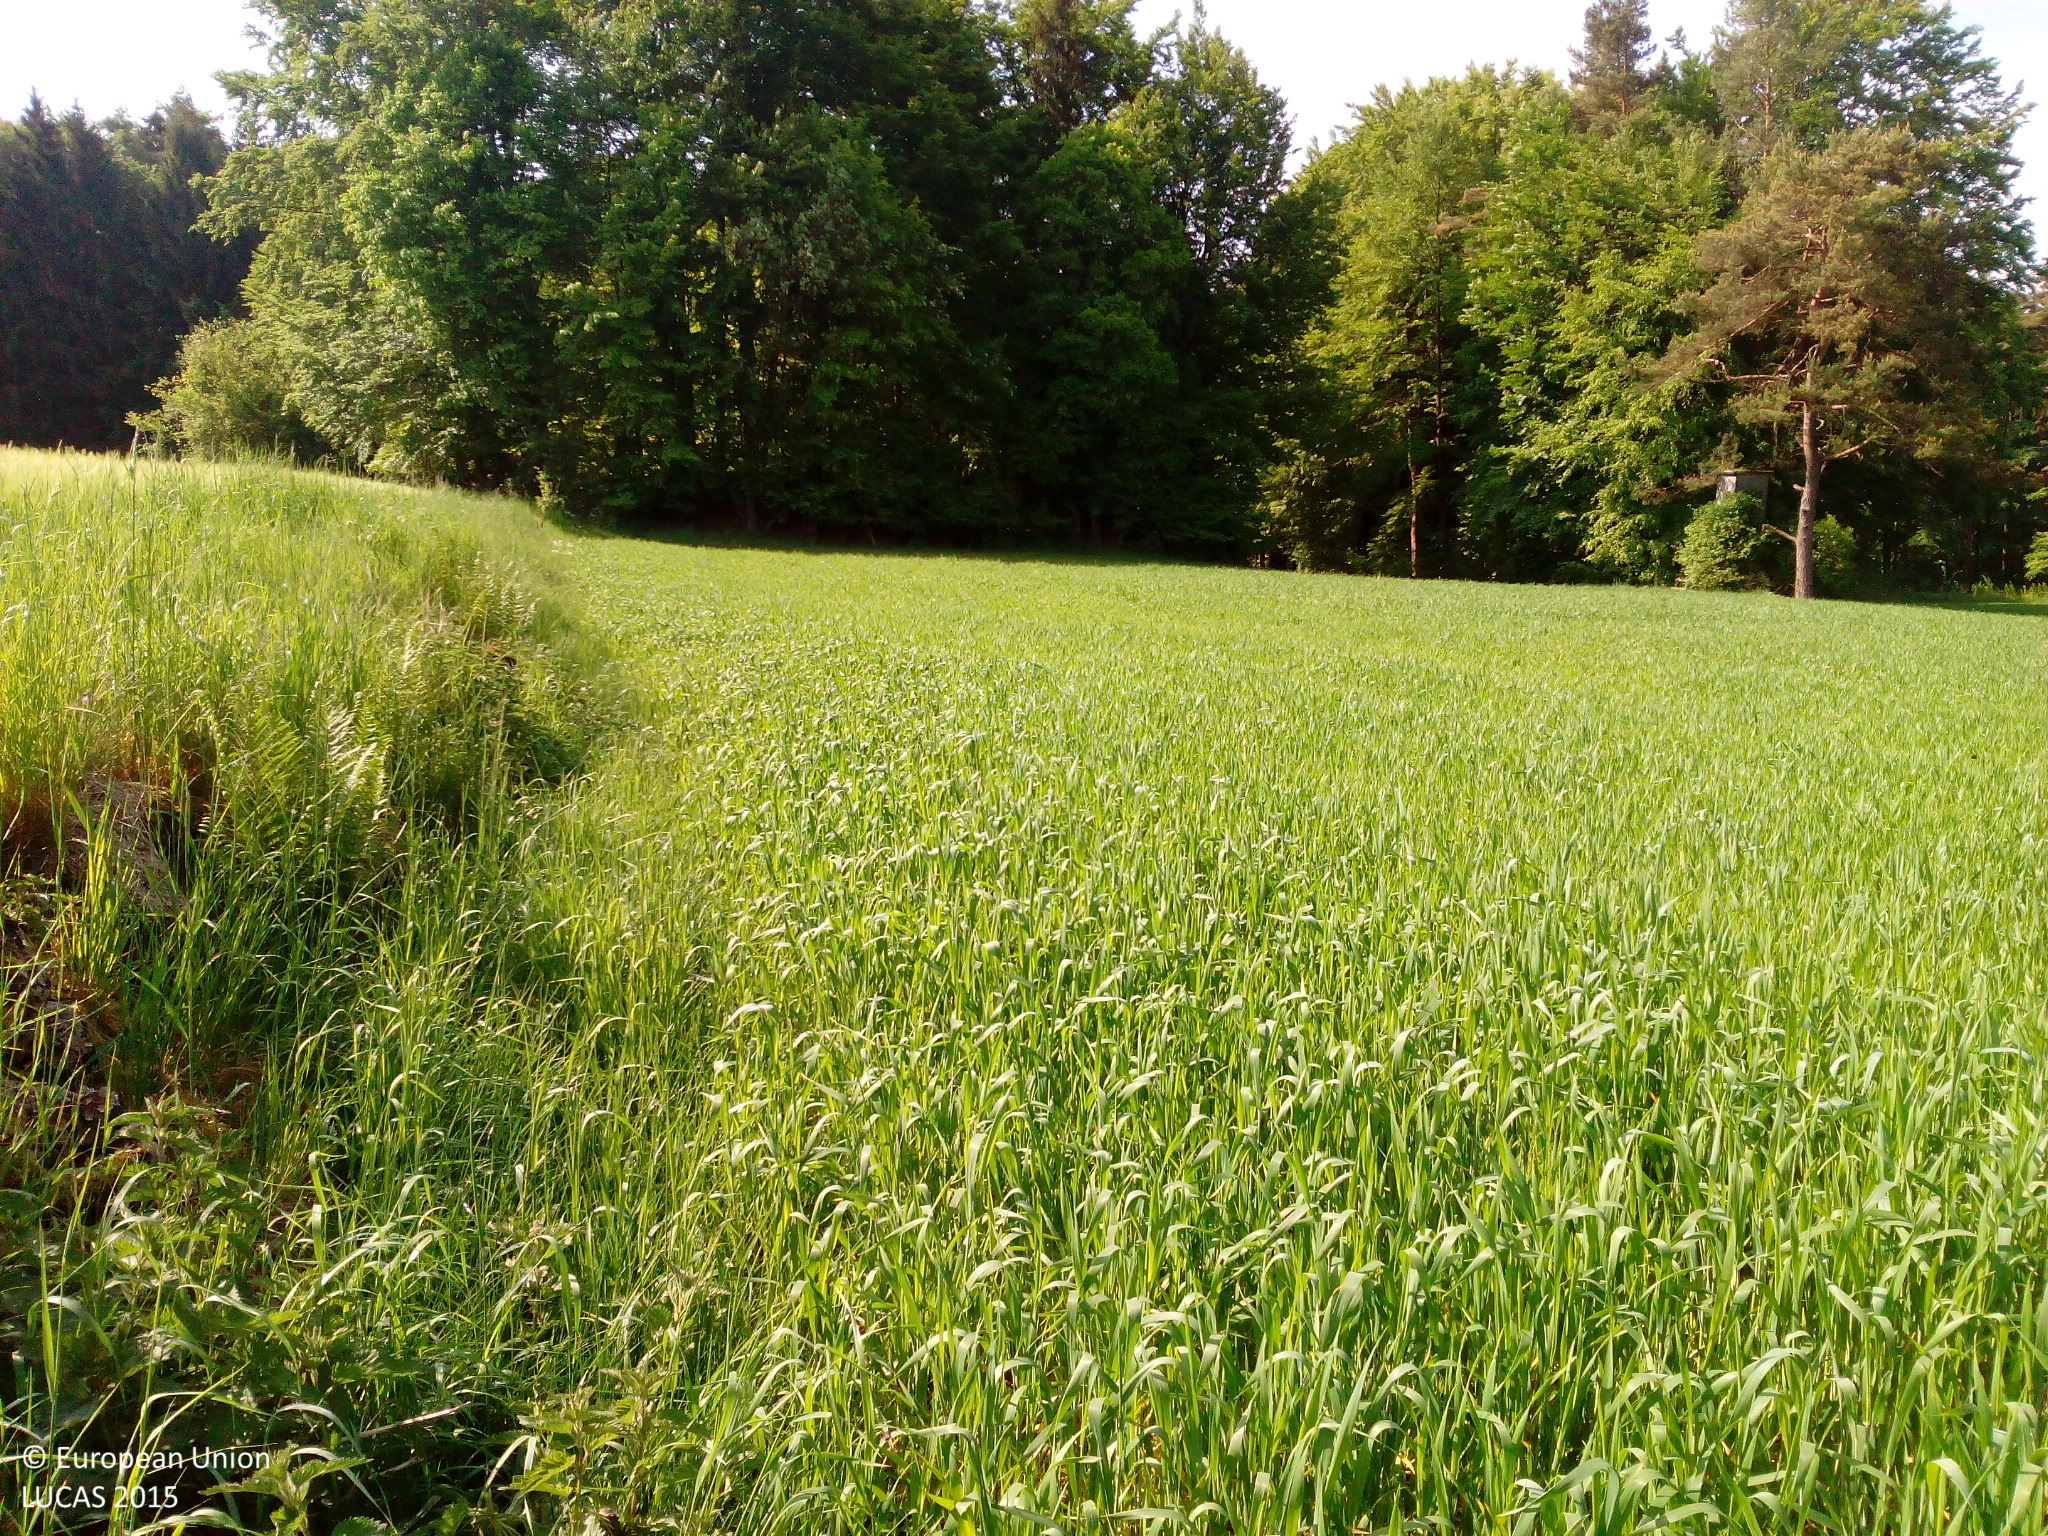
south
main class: Cropland
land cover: Triticale
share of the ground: > 75 %
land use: Agriculture (excluding fallow land and kitchen gardens)
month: May
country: DE
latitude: 49.4357
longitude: 11.5853
